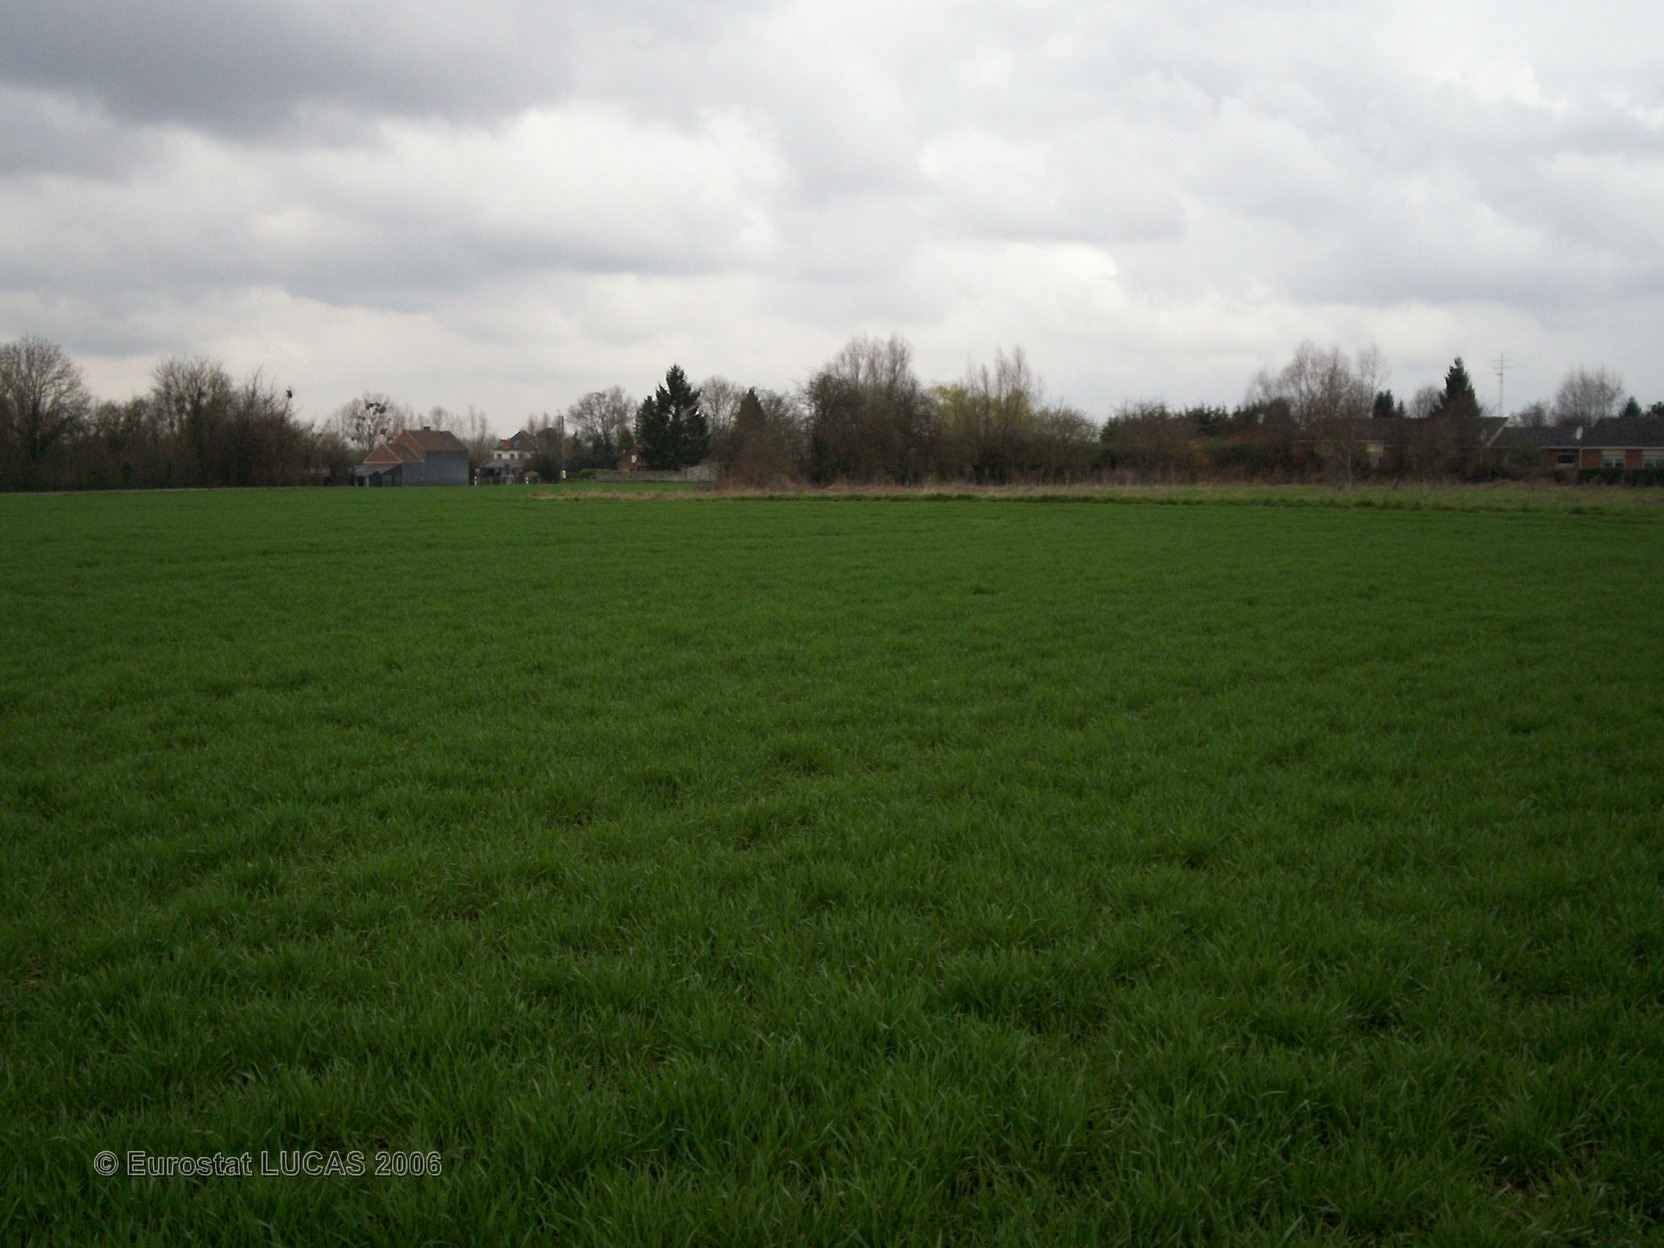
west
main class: Cropland
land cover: Common wheat
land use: Agriculture (excluding fallow land and kitchen gardens)
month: April
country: FR
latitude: 50.3206
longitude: 3.7715
